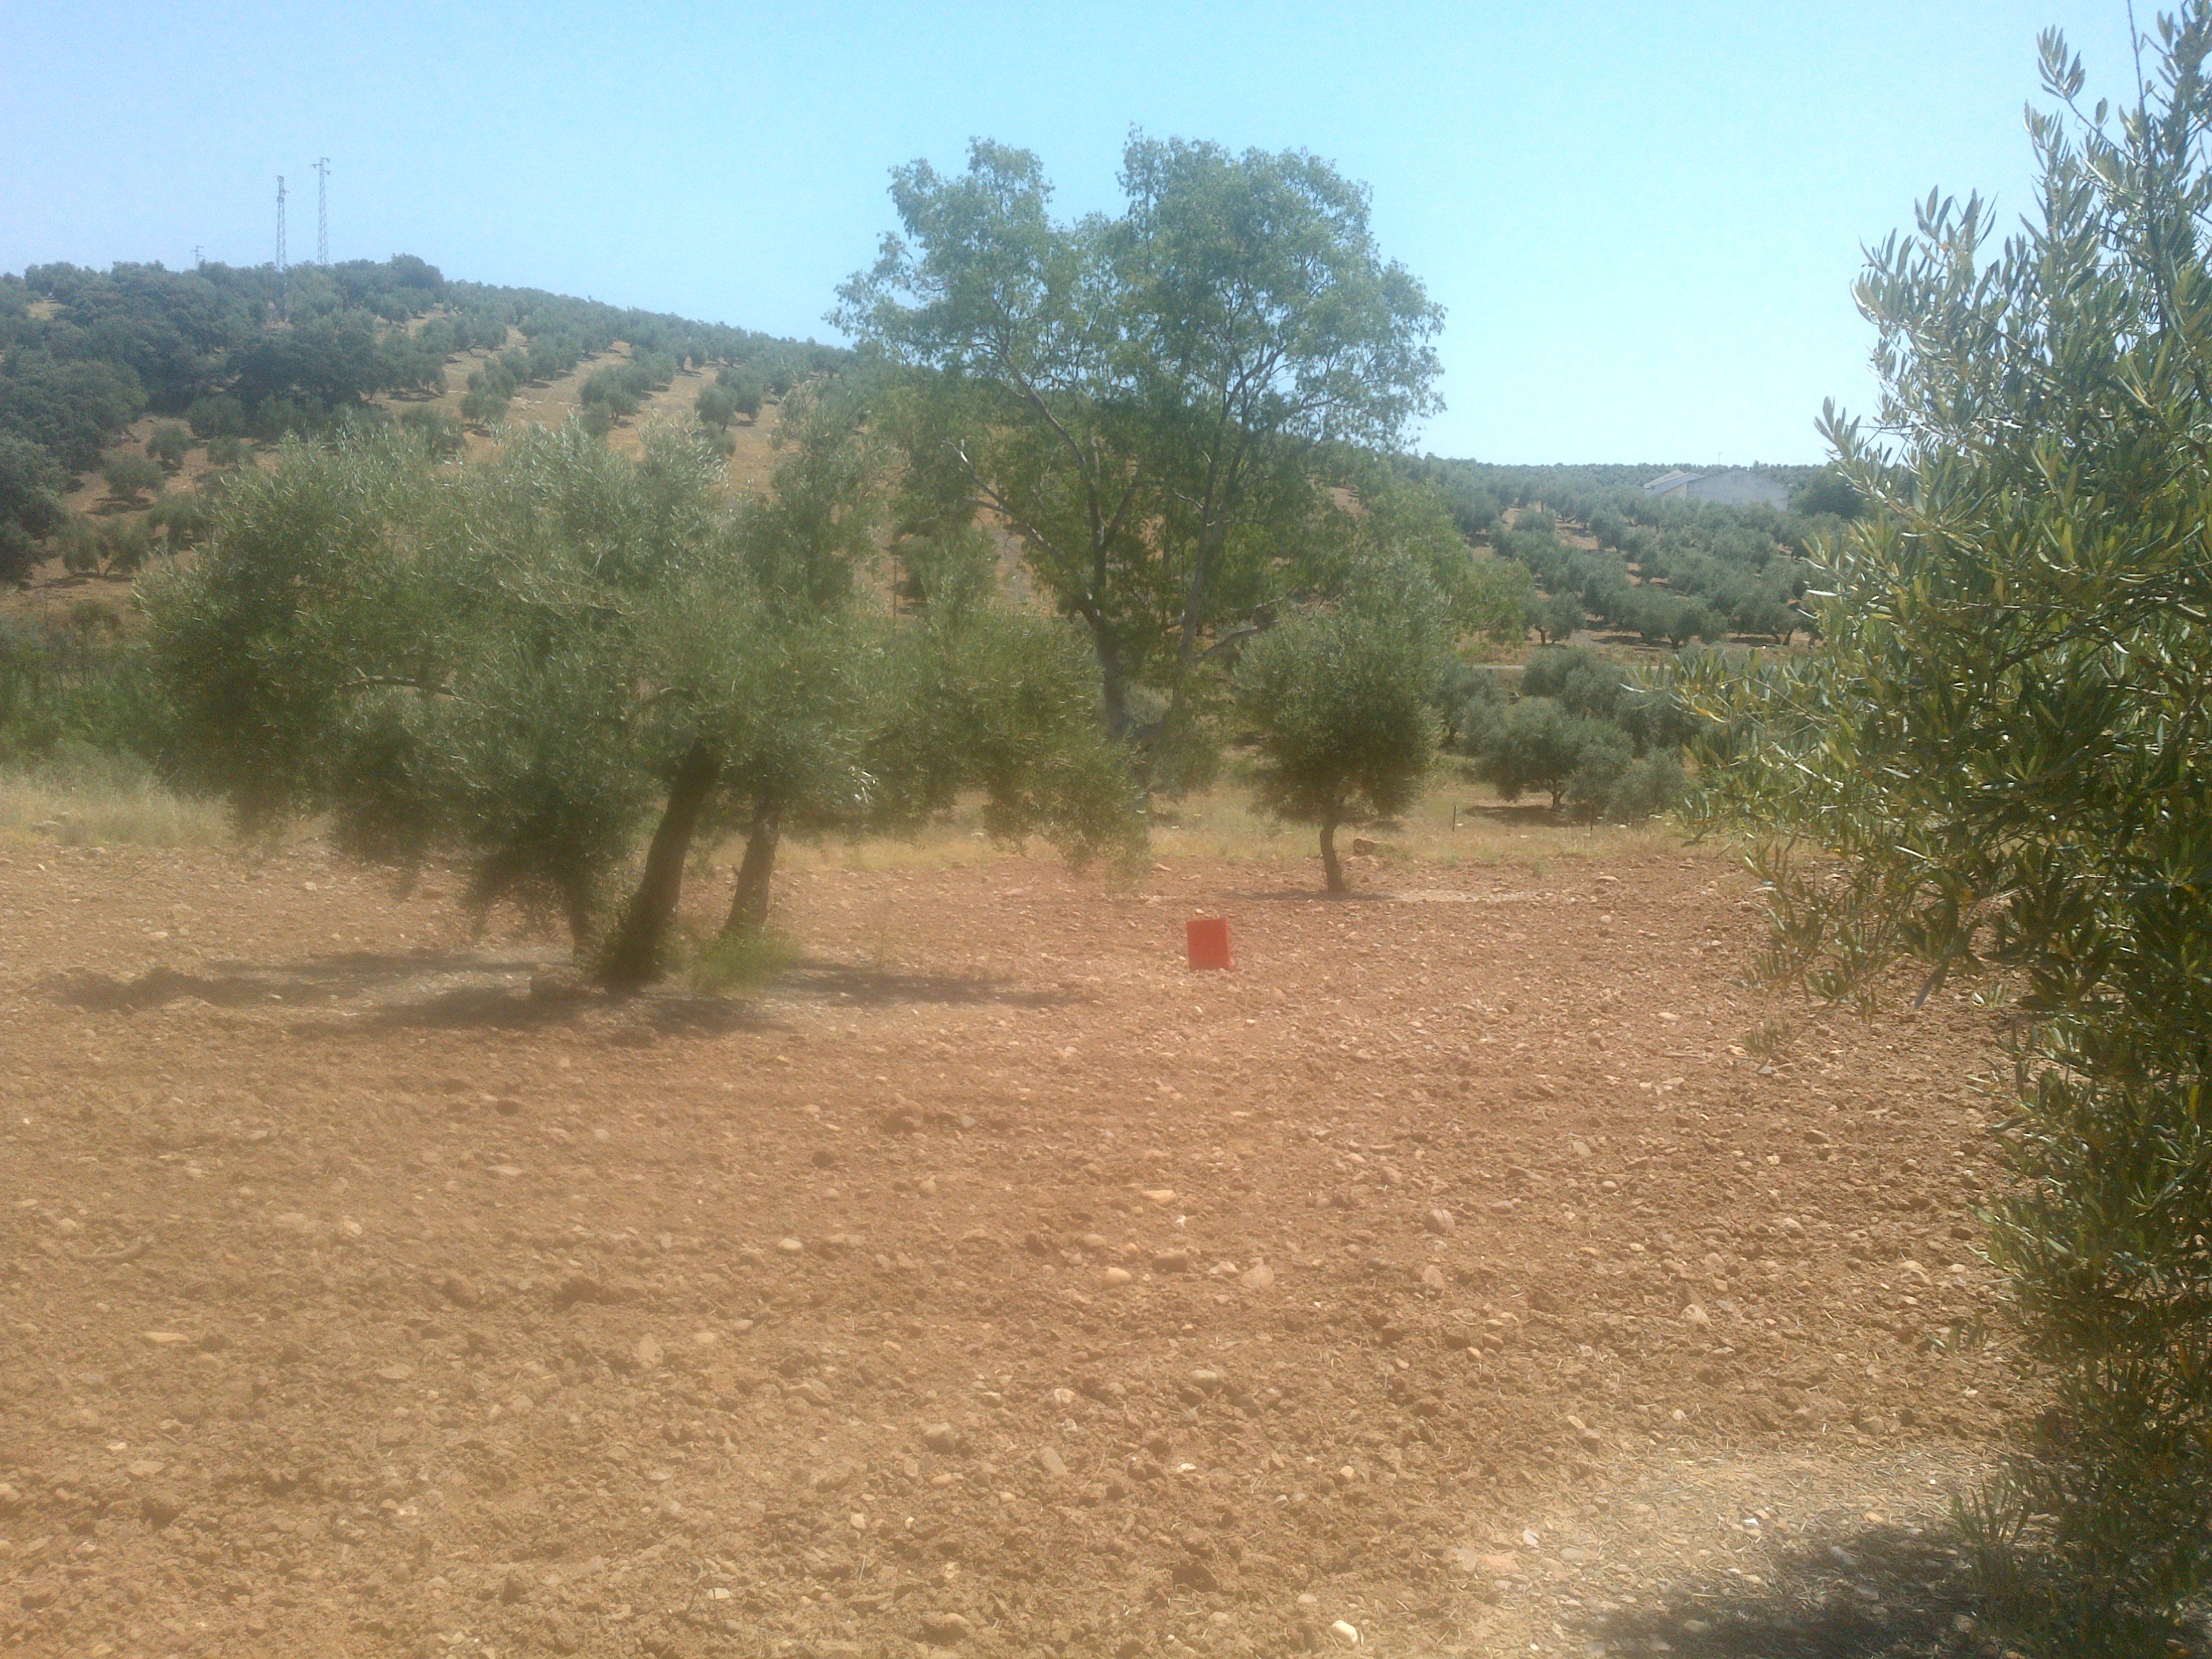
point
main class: Cropland
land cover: Olive groves
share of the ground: 25 - 50 %
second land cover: Other bare soil
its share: > 75 %
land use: Agriculture (excluding fallow land and kitchen gardens)
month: June
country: ES
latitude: 38.0197
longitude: -4.3062
